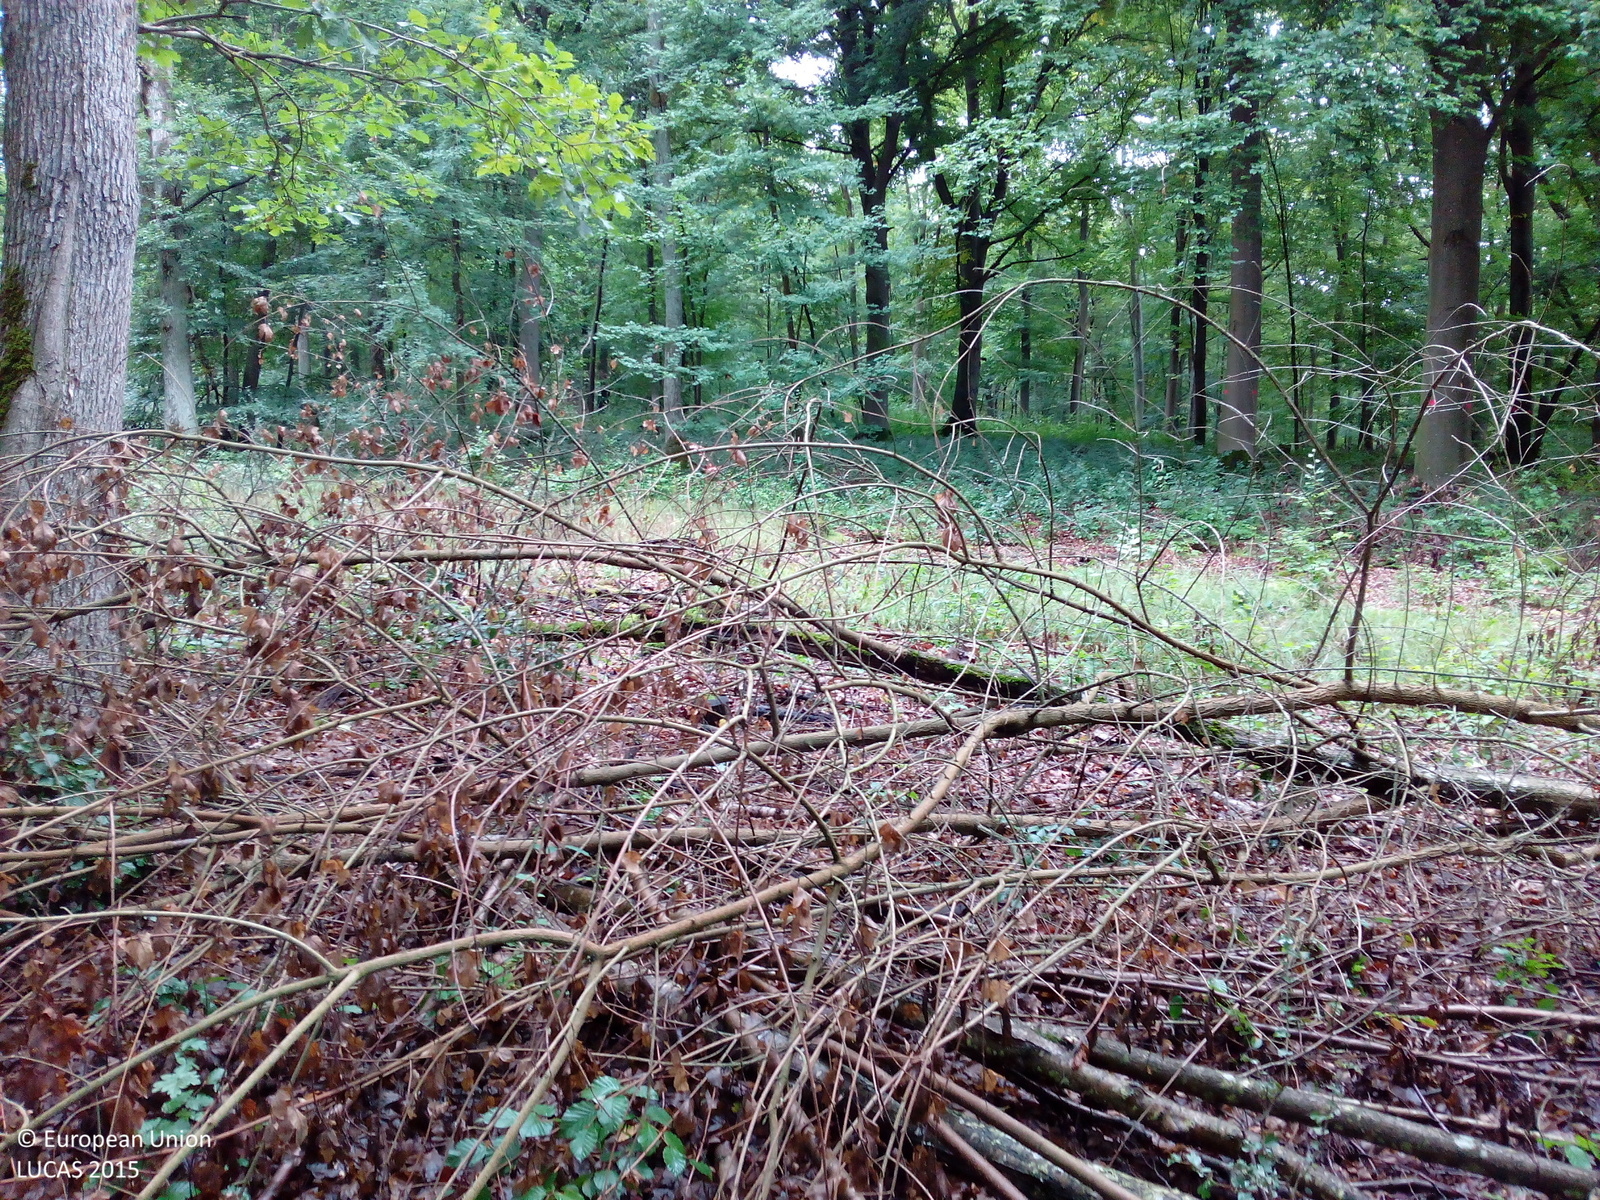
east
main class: Woodland
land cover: Broadleaved woodland
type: mesophytic deciduous forest
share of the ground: > 75 %
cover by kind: broadleaved forest trees 90 %, herbaceous plants 5 %, unconsolidated bare surface 5 %
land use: Forestry
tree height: > 5 m
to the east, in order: Broadleaved woodland; Spontaneously vegetated surfaces; Broadleaved woodland; Tracks; Broadleaved woodland
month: September
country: DE
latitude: 50.0763
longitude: 9.9581
